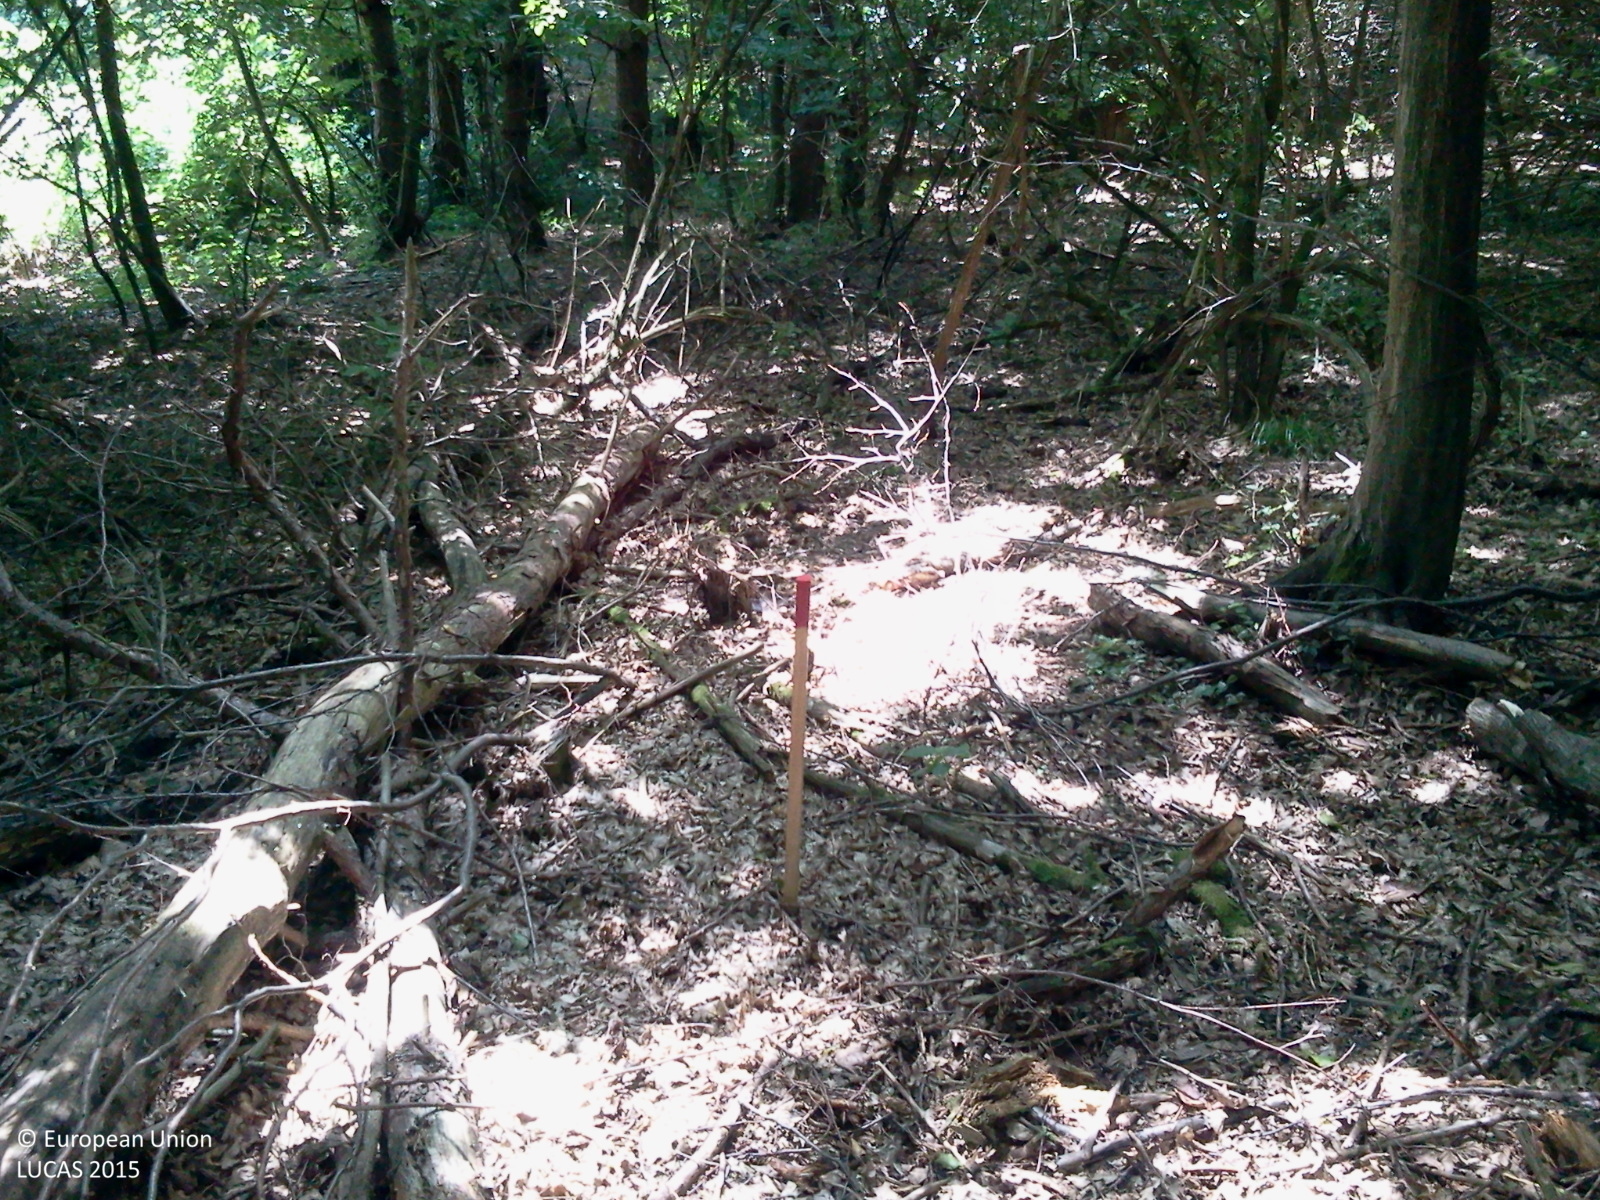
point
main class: Woodland
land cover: Broadleaved woodland
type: thermophilous deciduous forest
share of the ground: > 75 %
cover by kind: broadleaved forest trees 95 %, unconsolidated bare surface 5 %
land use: Forestry
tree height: > 5 m
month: June
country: HU
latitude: 46.8434
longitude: 17.0194
